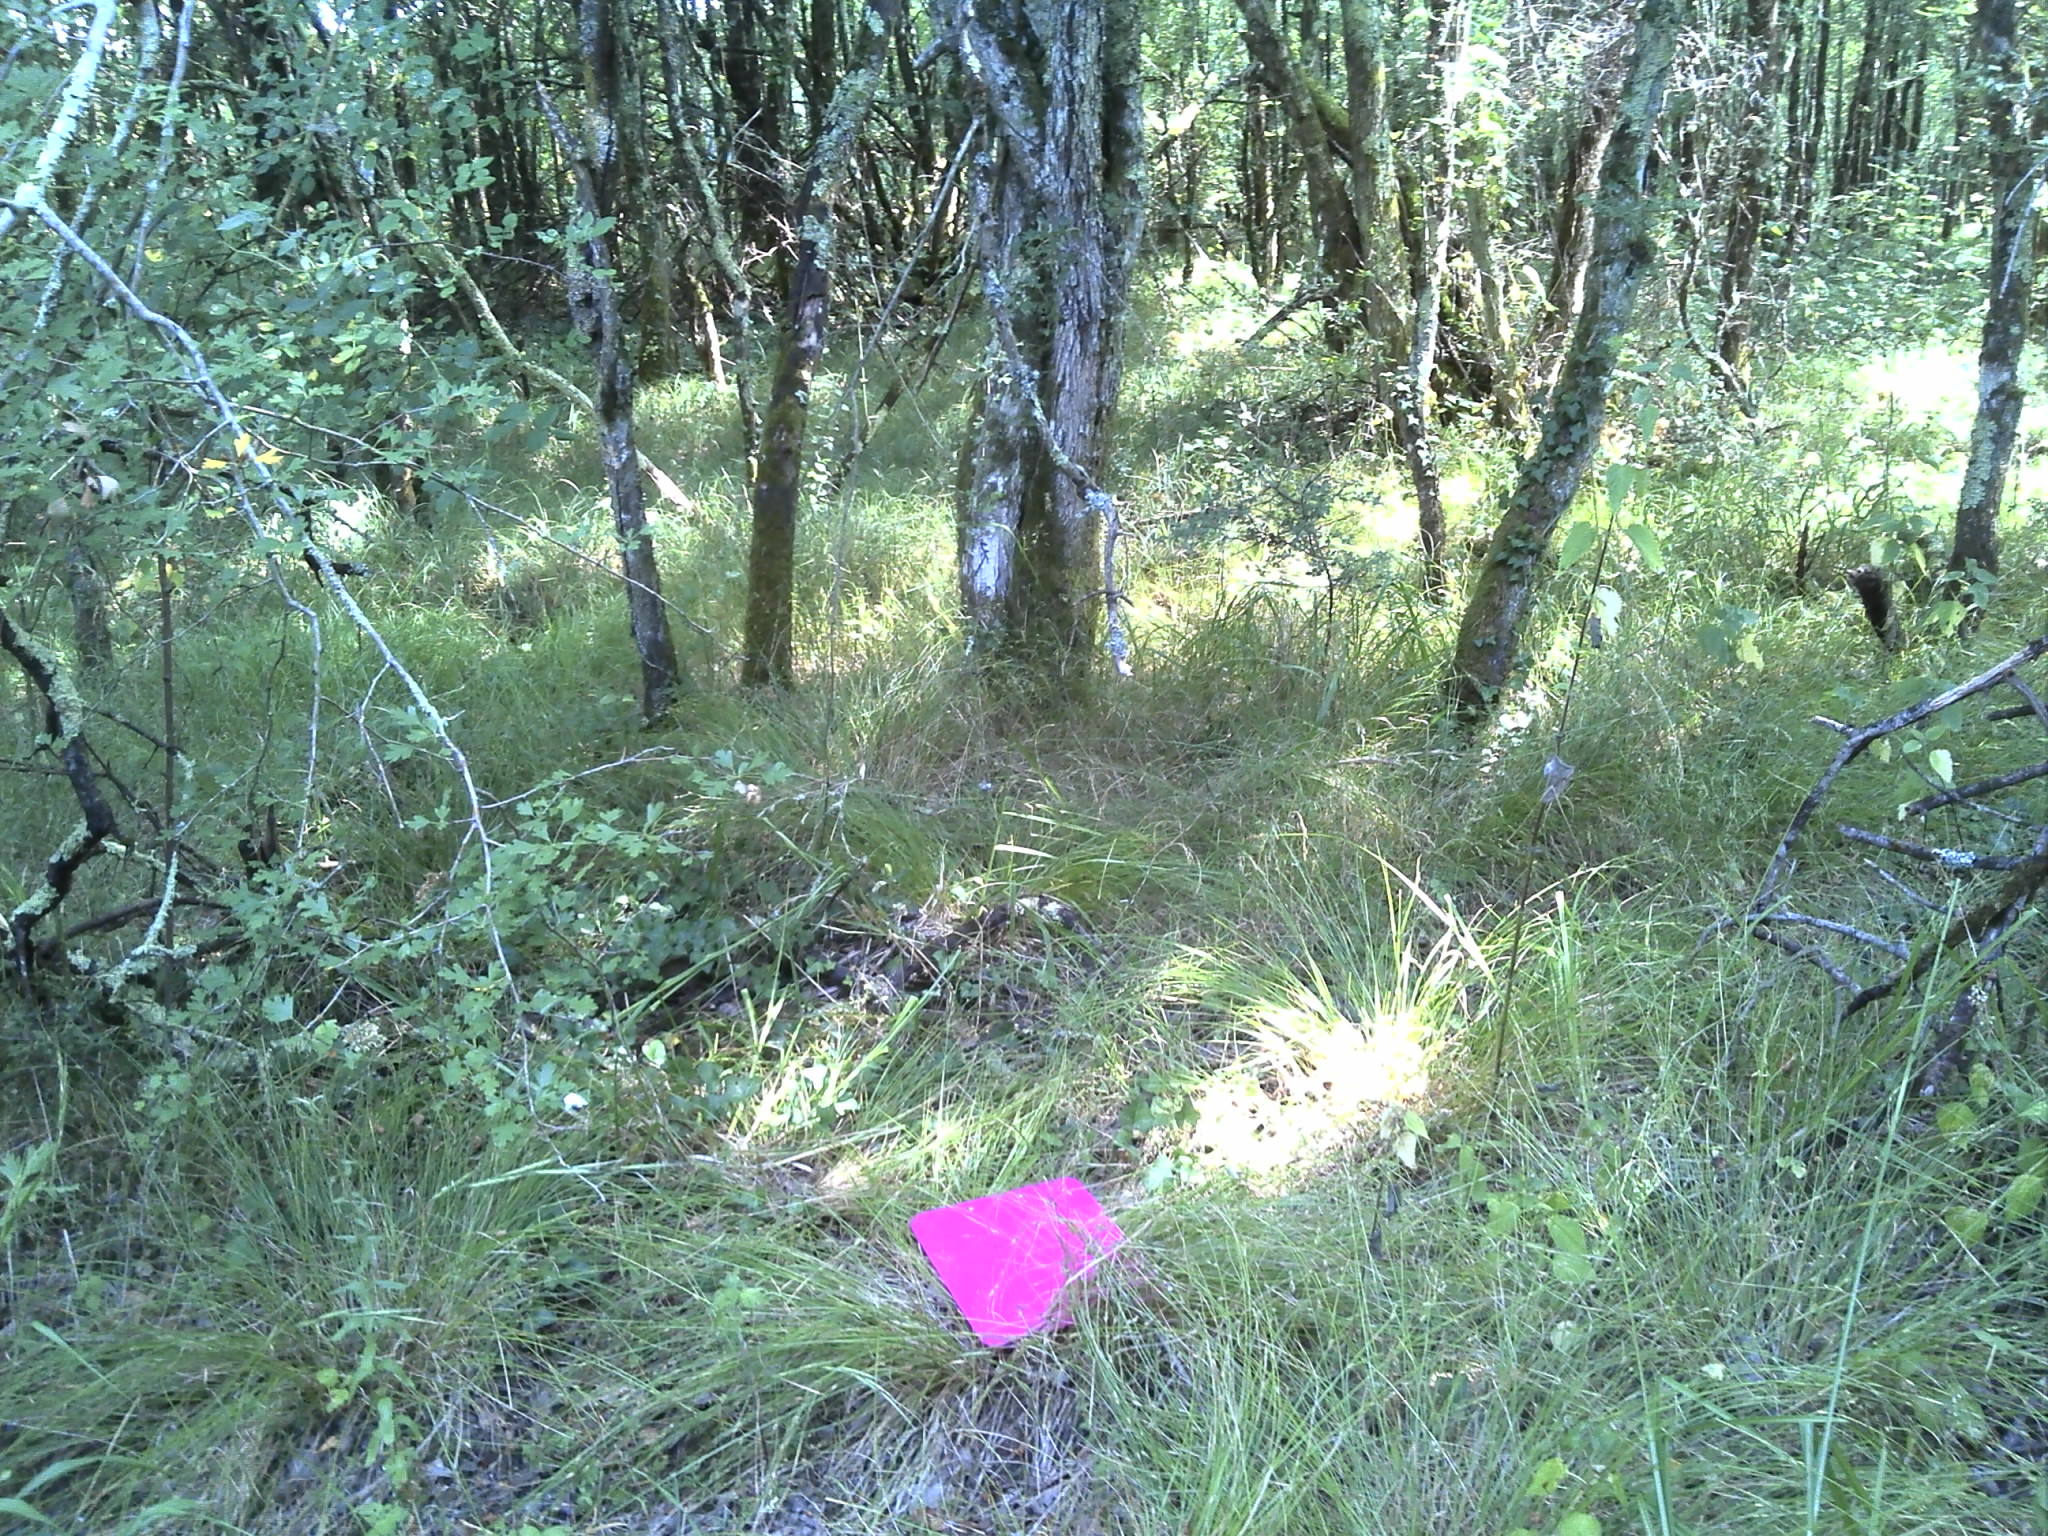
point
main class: Woodland
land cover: Broadleaved woodland
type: mesophytic deciduous forest
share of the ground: > 75 %
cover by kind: broadleaved forest trees 95 %, herbaceous plants 5 %
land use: Forestry
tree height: > 5 m
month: July
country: FR
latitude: 46.6867
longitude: 1.5560
